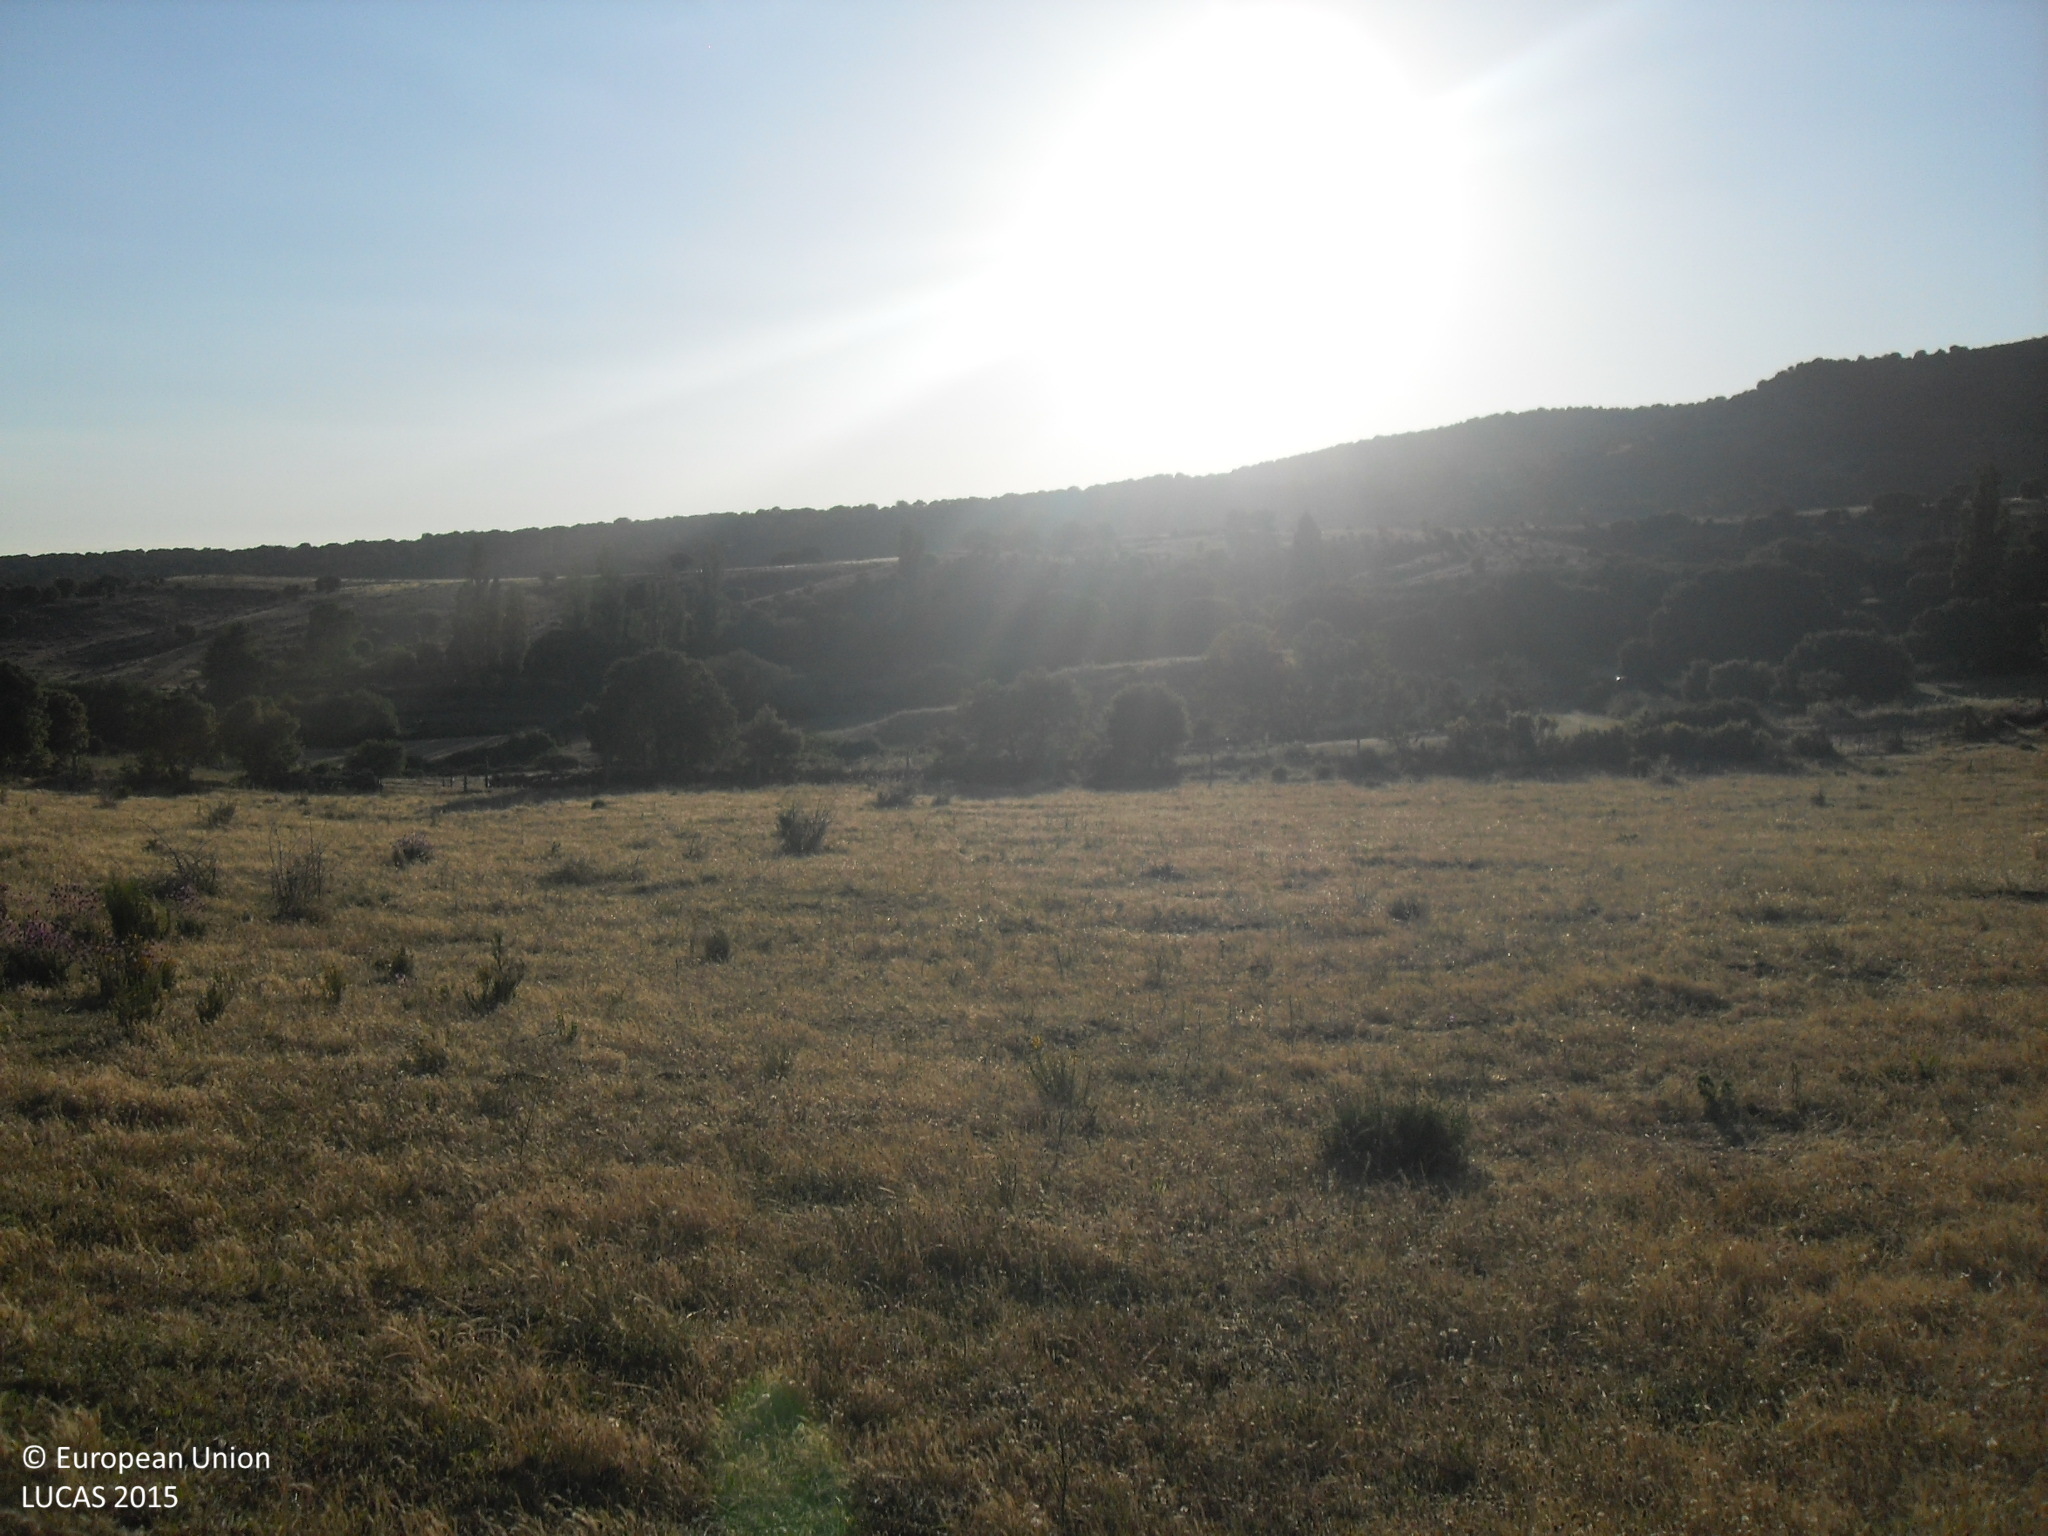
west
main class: Grassland
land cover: Grassland without tree/shrub cover
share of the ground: > 75 %
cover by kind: herbaceous plants 100 %
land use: Agriculture (excluding fallow land and kitchen gardens)
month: May
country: ES
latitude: 40.5534
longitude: -5.2621
